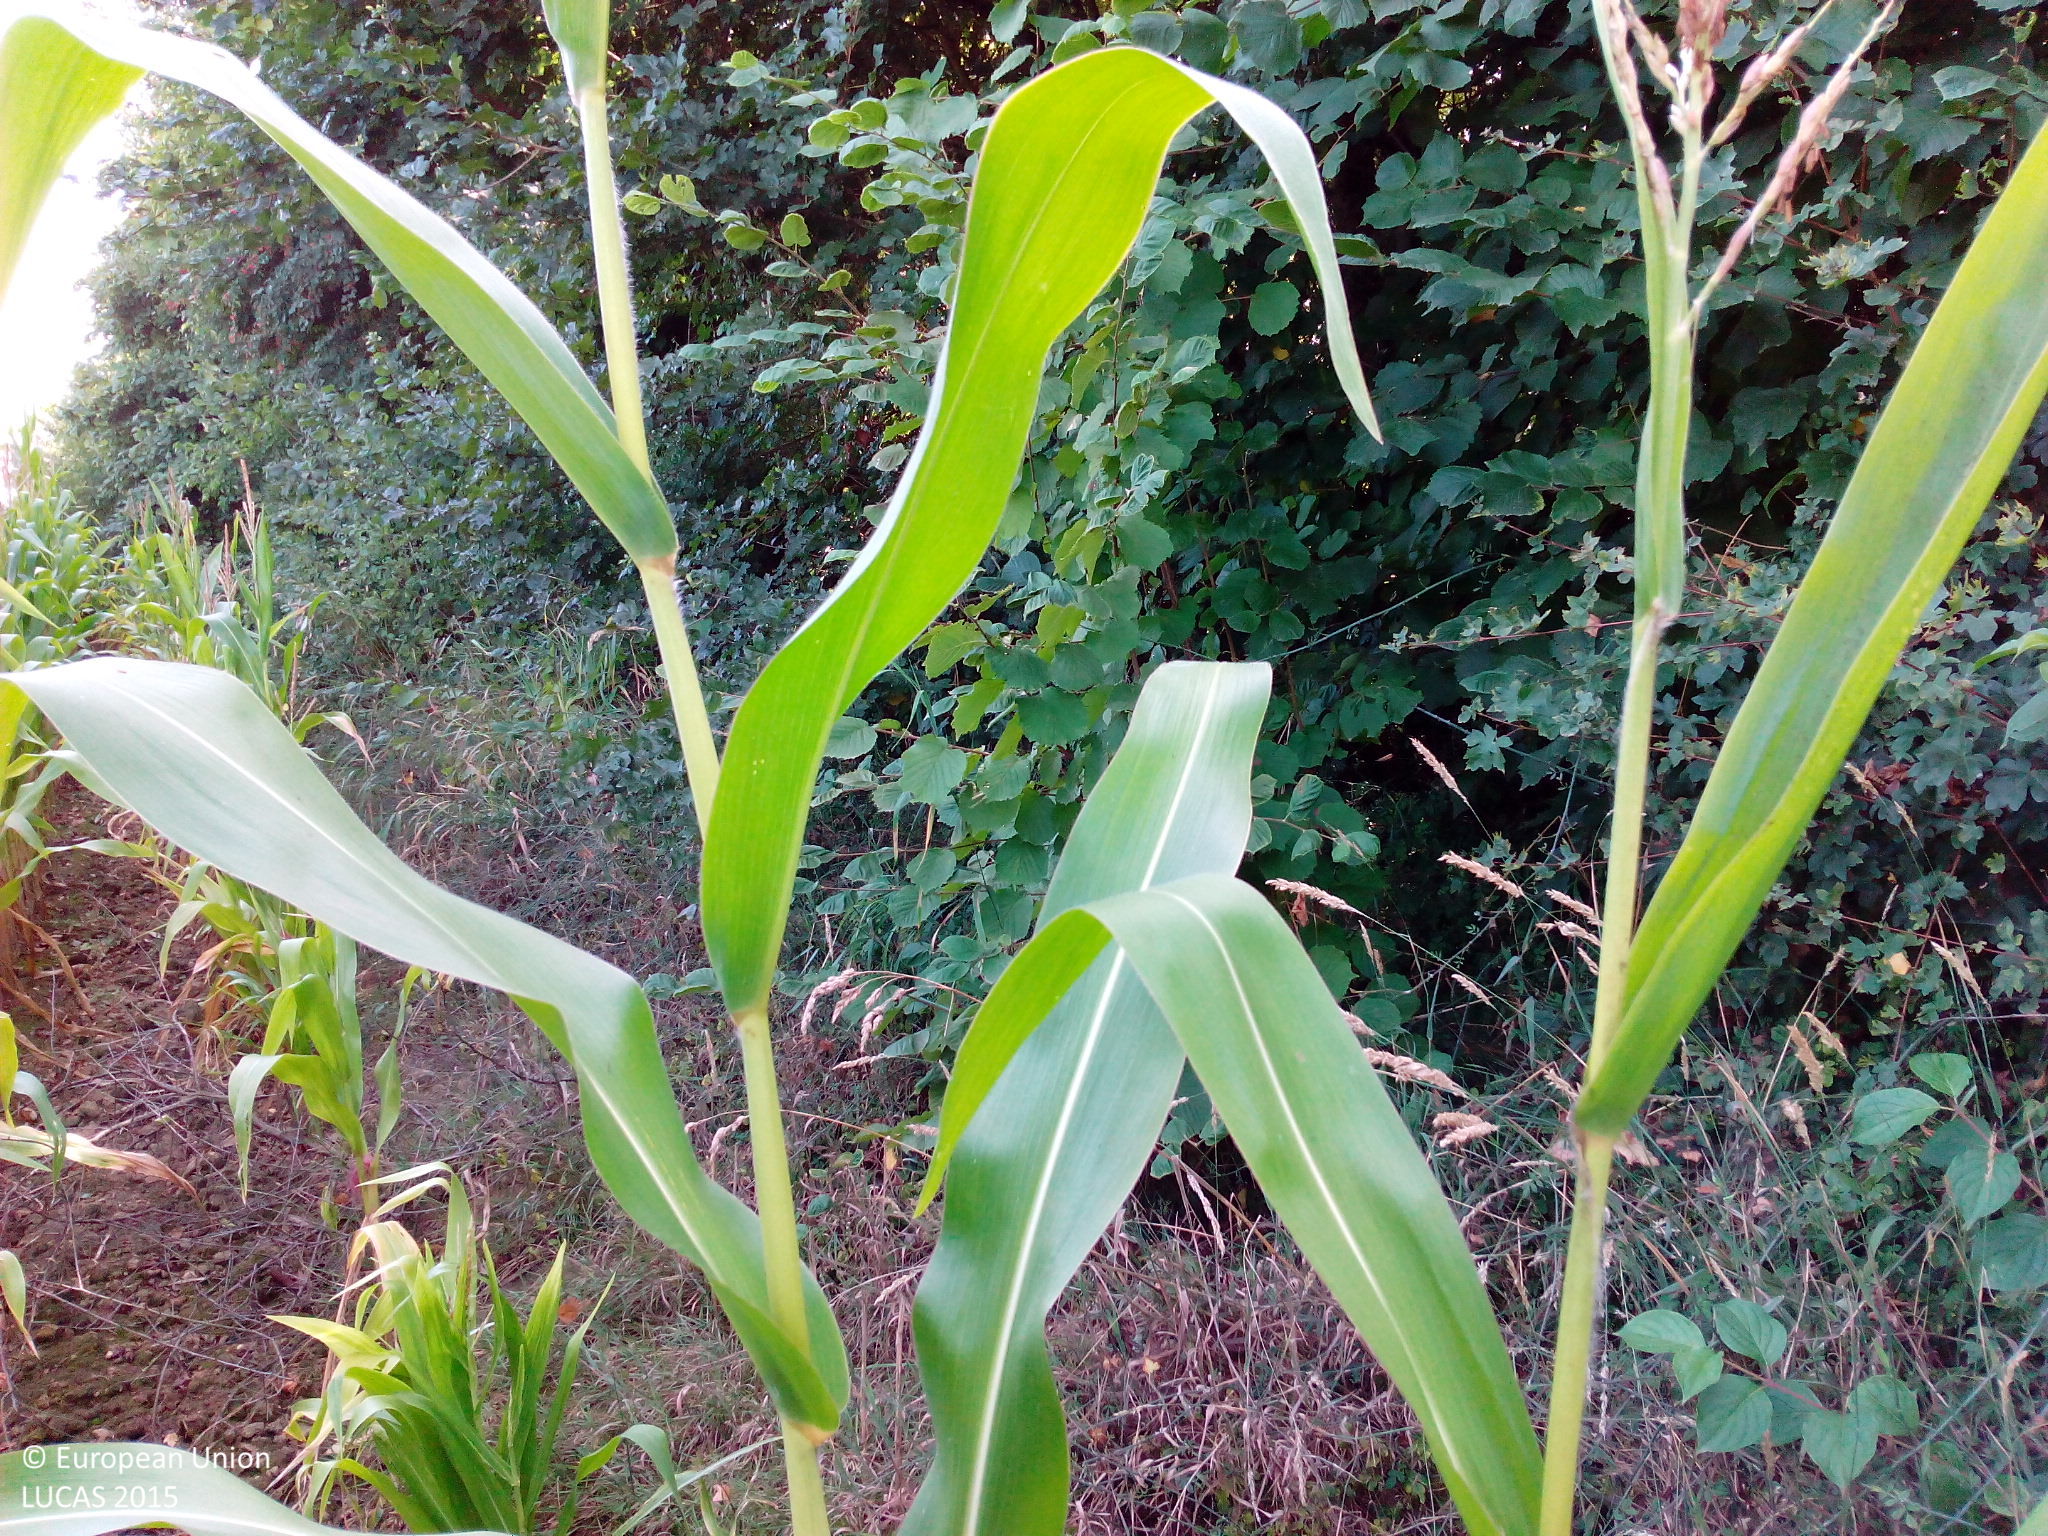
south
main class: Cropland
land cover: Maize
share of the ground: > 75 %
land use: Agriculture (excluding fallow land and kitchen gardens)
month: August
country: DE
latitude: 48.2775
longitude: 9.9327
